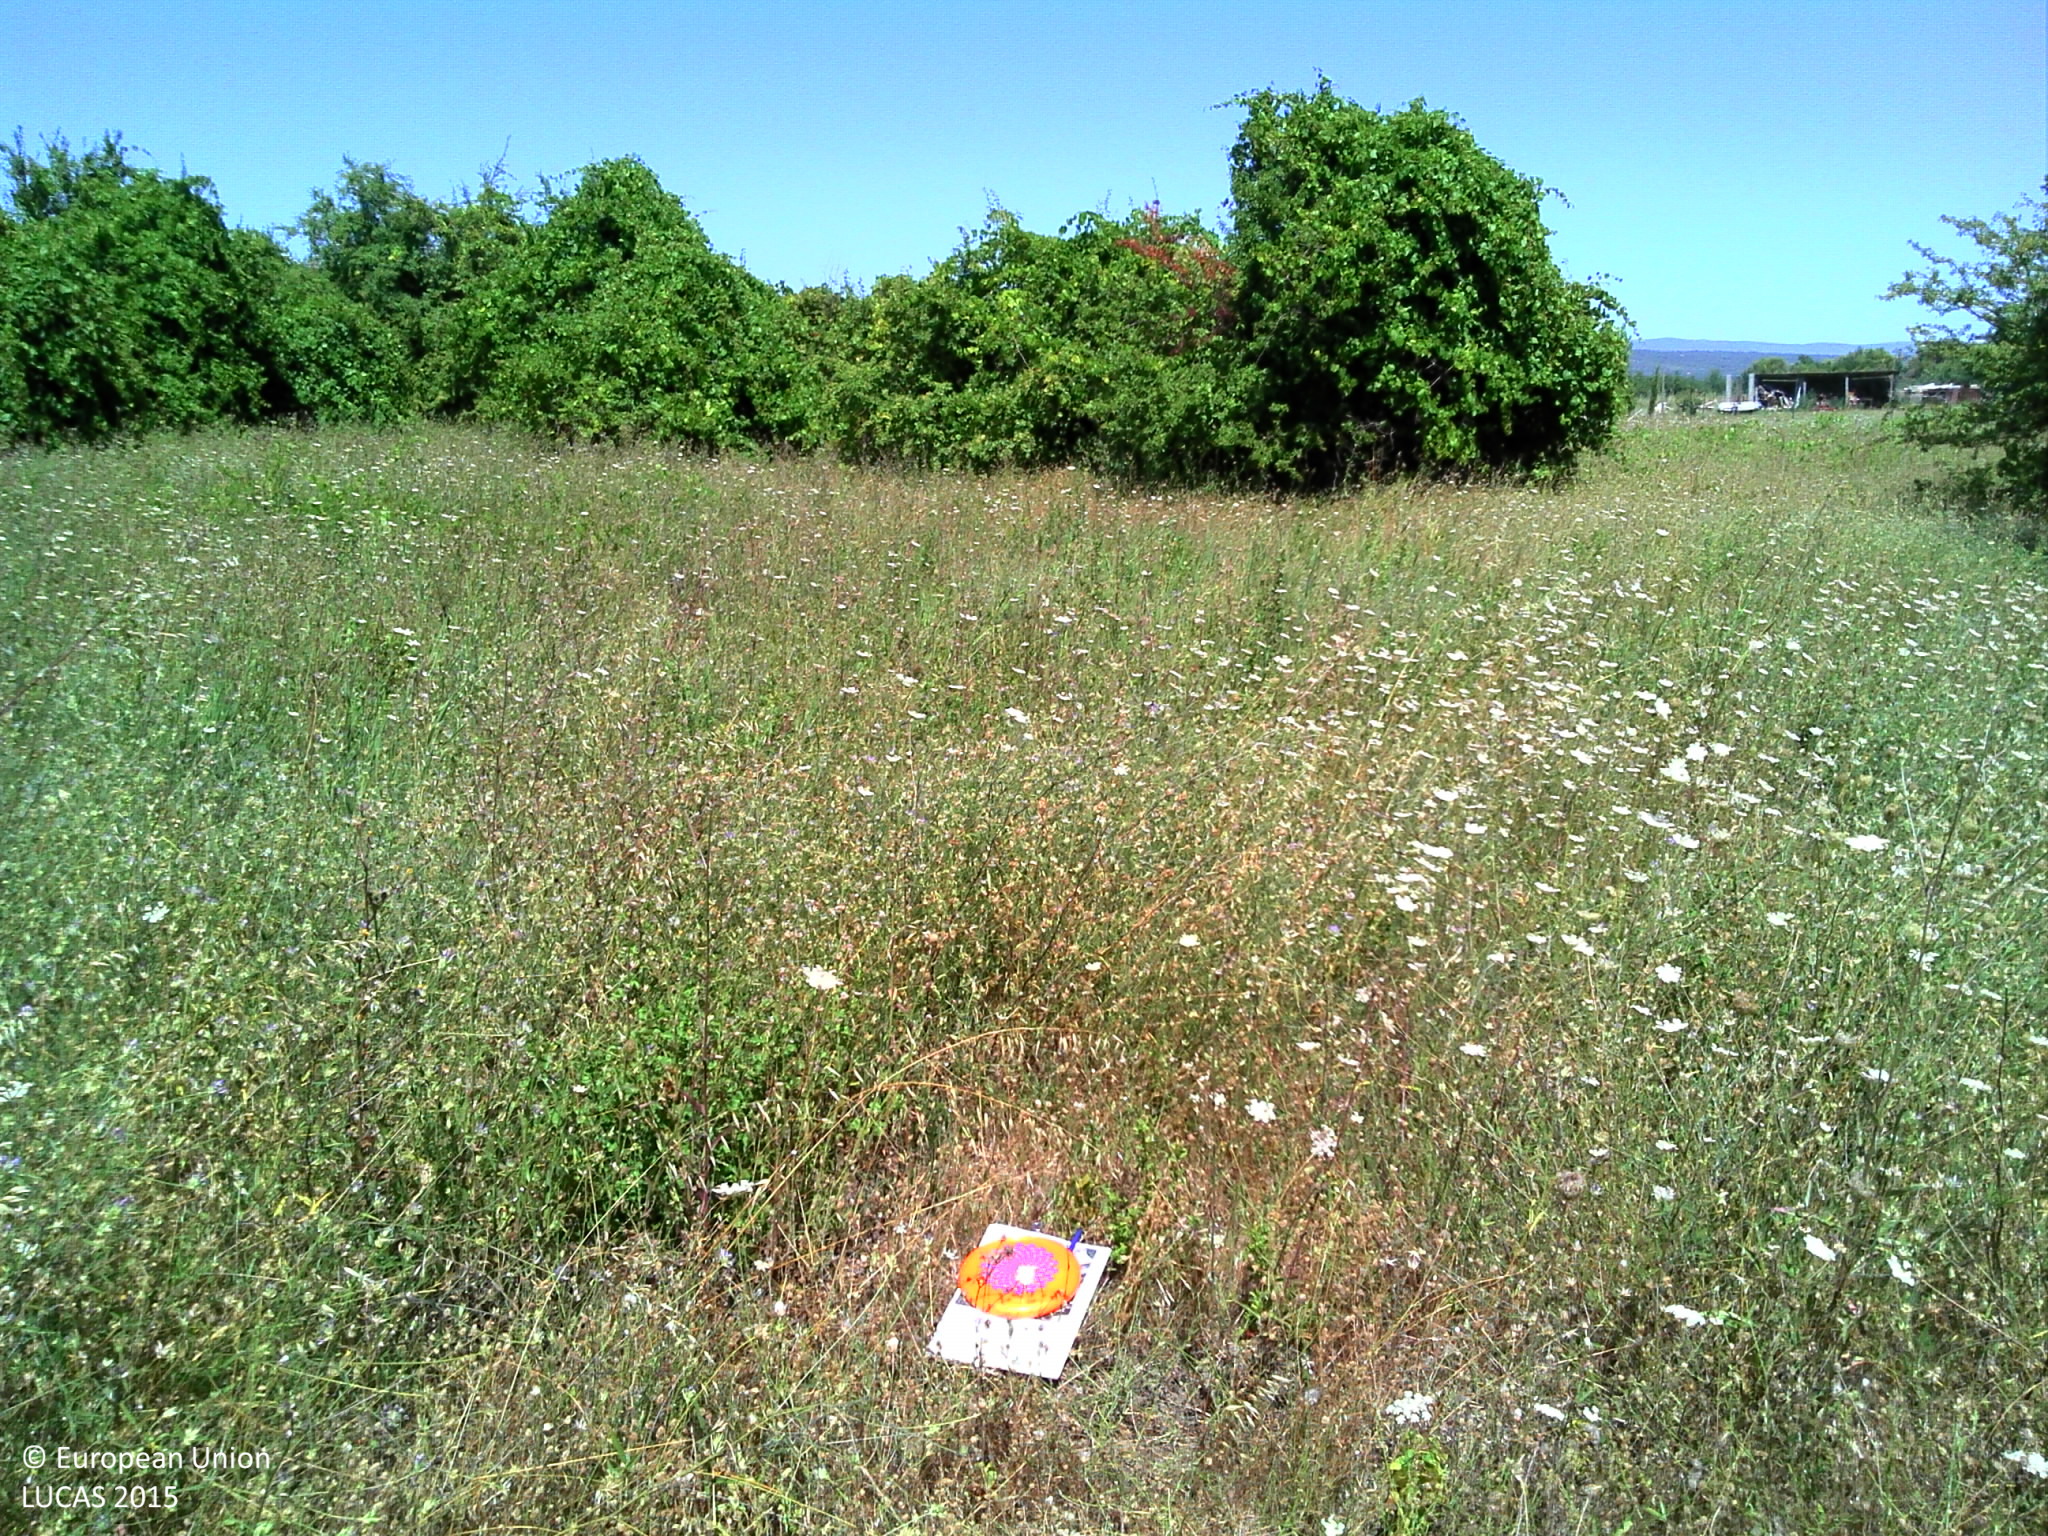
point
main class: Grassland
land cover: Grassland with sparse tree/shrub cover
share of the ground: > 75 %
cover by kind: herbaceous plants 90 %, broadleaved forest trees 5 %, shrubs 5 %
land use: Semi-natural and natural areas not in use
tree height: < 5 m
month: July
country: FR
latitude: 43.8563
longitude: 5.1196
